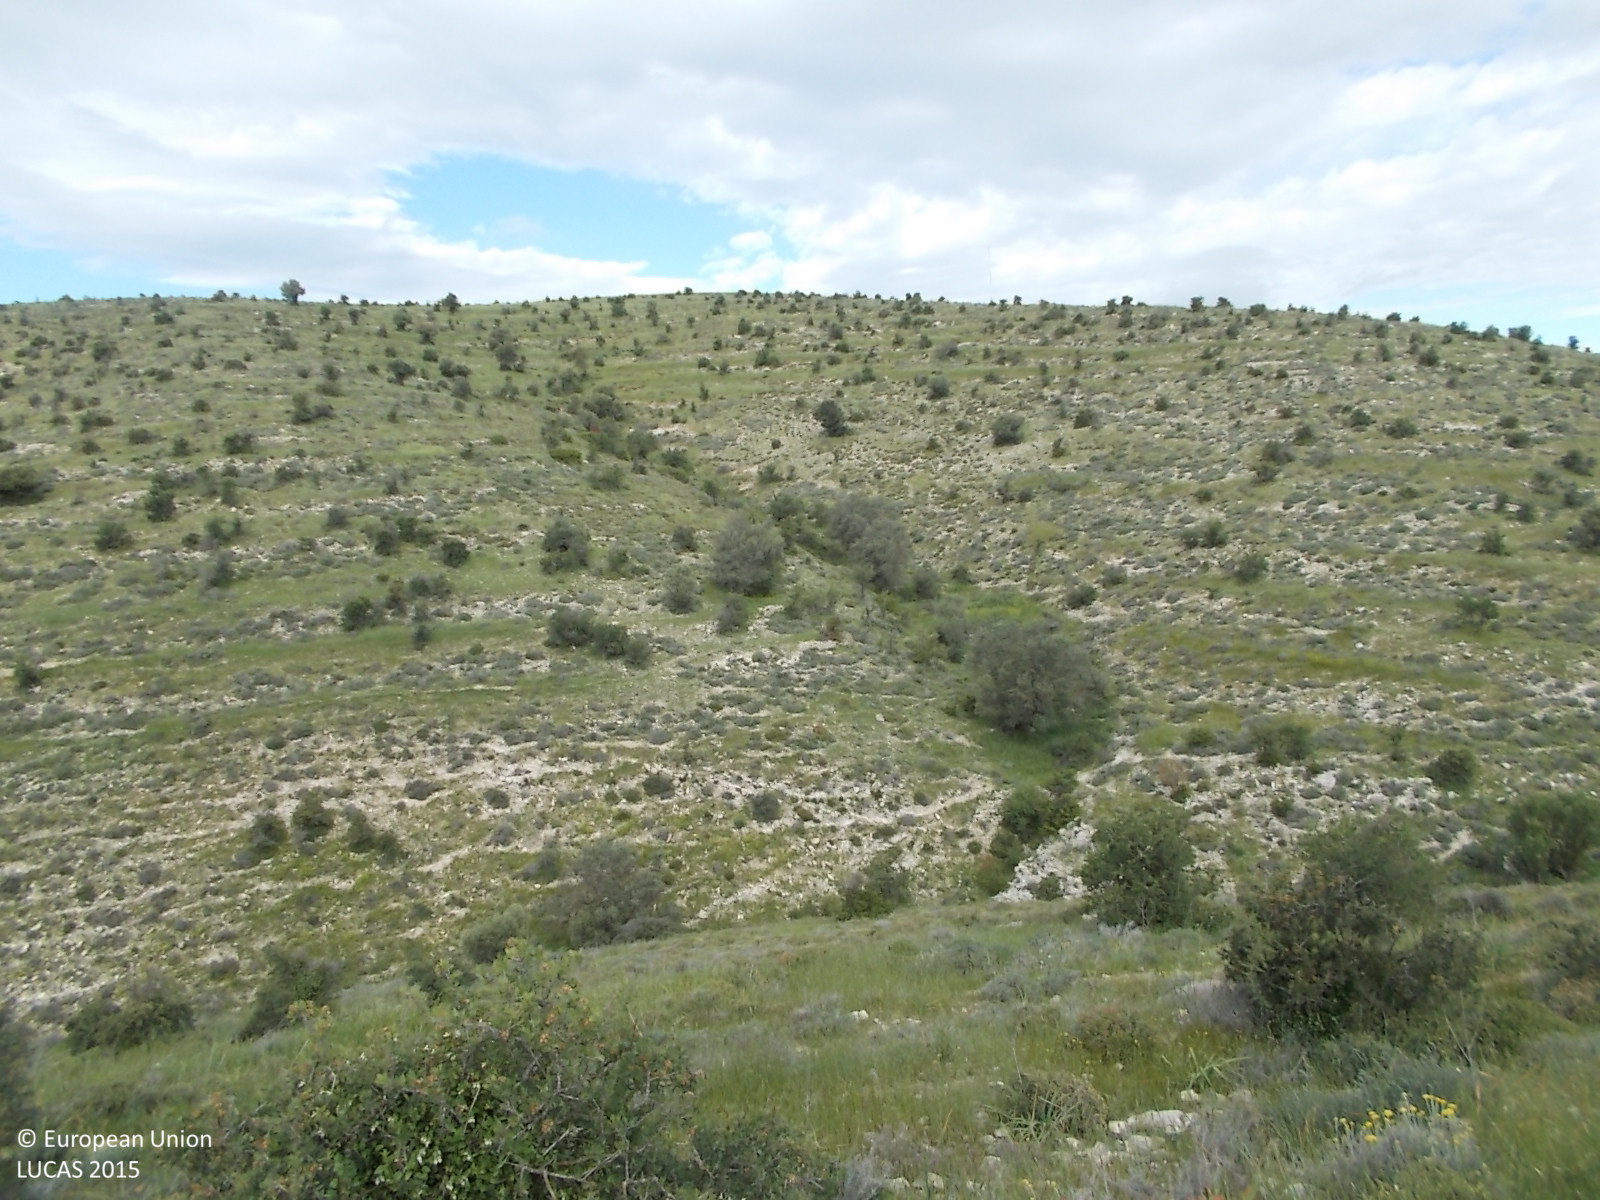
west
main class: Shrubland
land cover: Shrubland without tree cover
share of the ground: 50 - 75 %
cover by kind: shrubs 60 %, unconsolidated bare surface 30 %, herbaceous plants 10 %
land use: Semi-natural and natural areas not in use
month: April
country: CY
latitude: 34.9680
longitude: 33.4883
